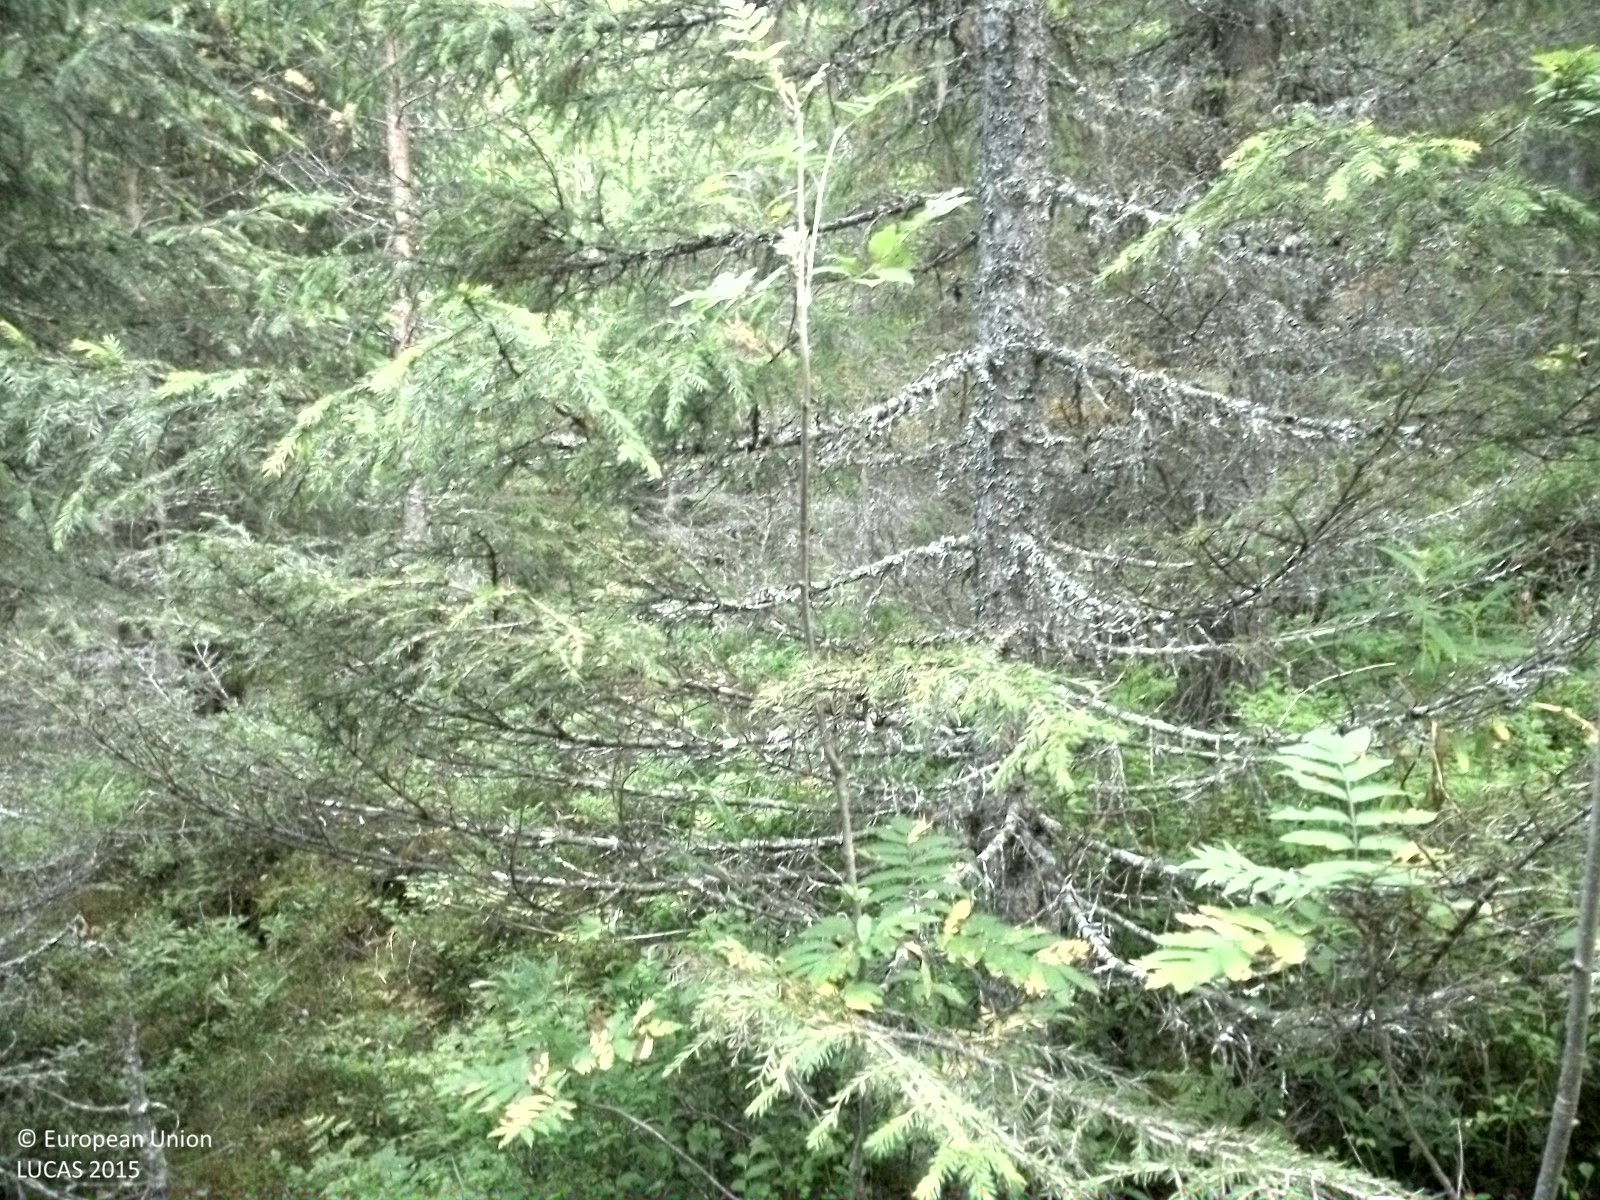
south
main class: Woodland
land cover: Spruce dominated coniferous woodland
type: boreal forest
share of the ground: 50 - 75 %
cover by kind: coniferous forest trees 60 %, shrubs 35 %, broadleaved forest trees 5 %
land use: Forestry
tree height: > 5 m
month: August
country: SE
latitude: 62.2753
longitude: 16.0112
